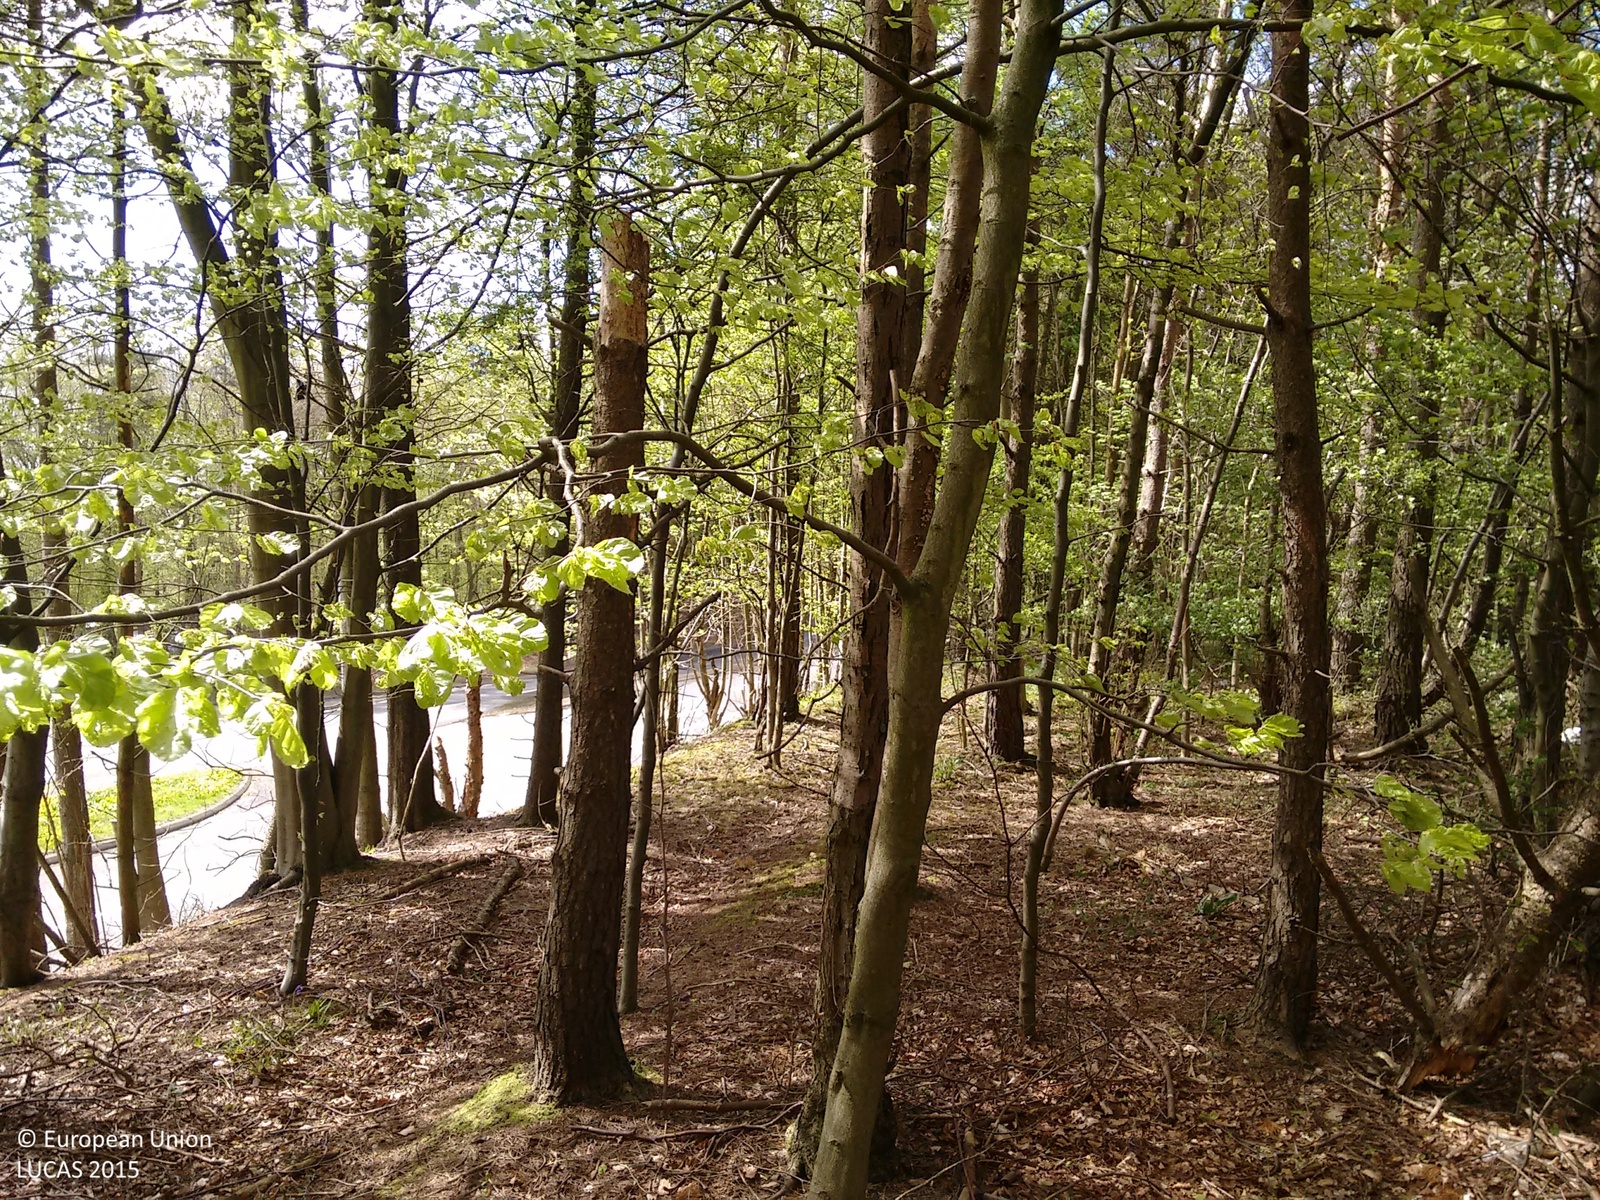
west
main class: Woodland
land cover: Broadleaved woodland
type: exotic forest
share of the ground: > 75 %
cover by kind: broadleaved forest trees 90 %, coniferous forest trees 10 %
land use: Amenities, museums, leisure
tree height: > 5 m
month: May
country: GB
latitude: 55.9695
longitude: -3.9454
